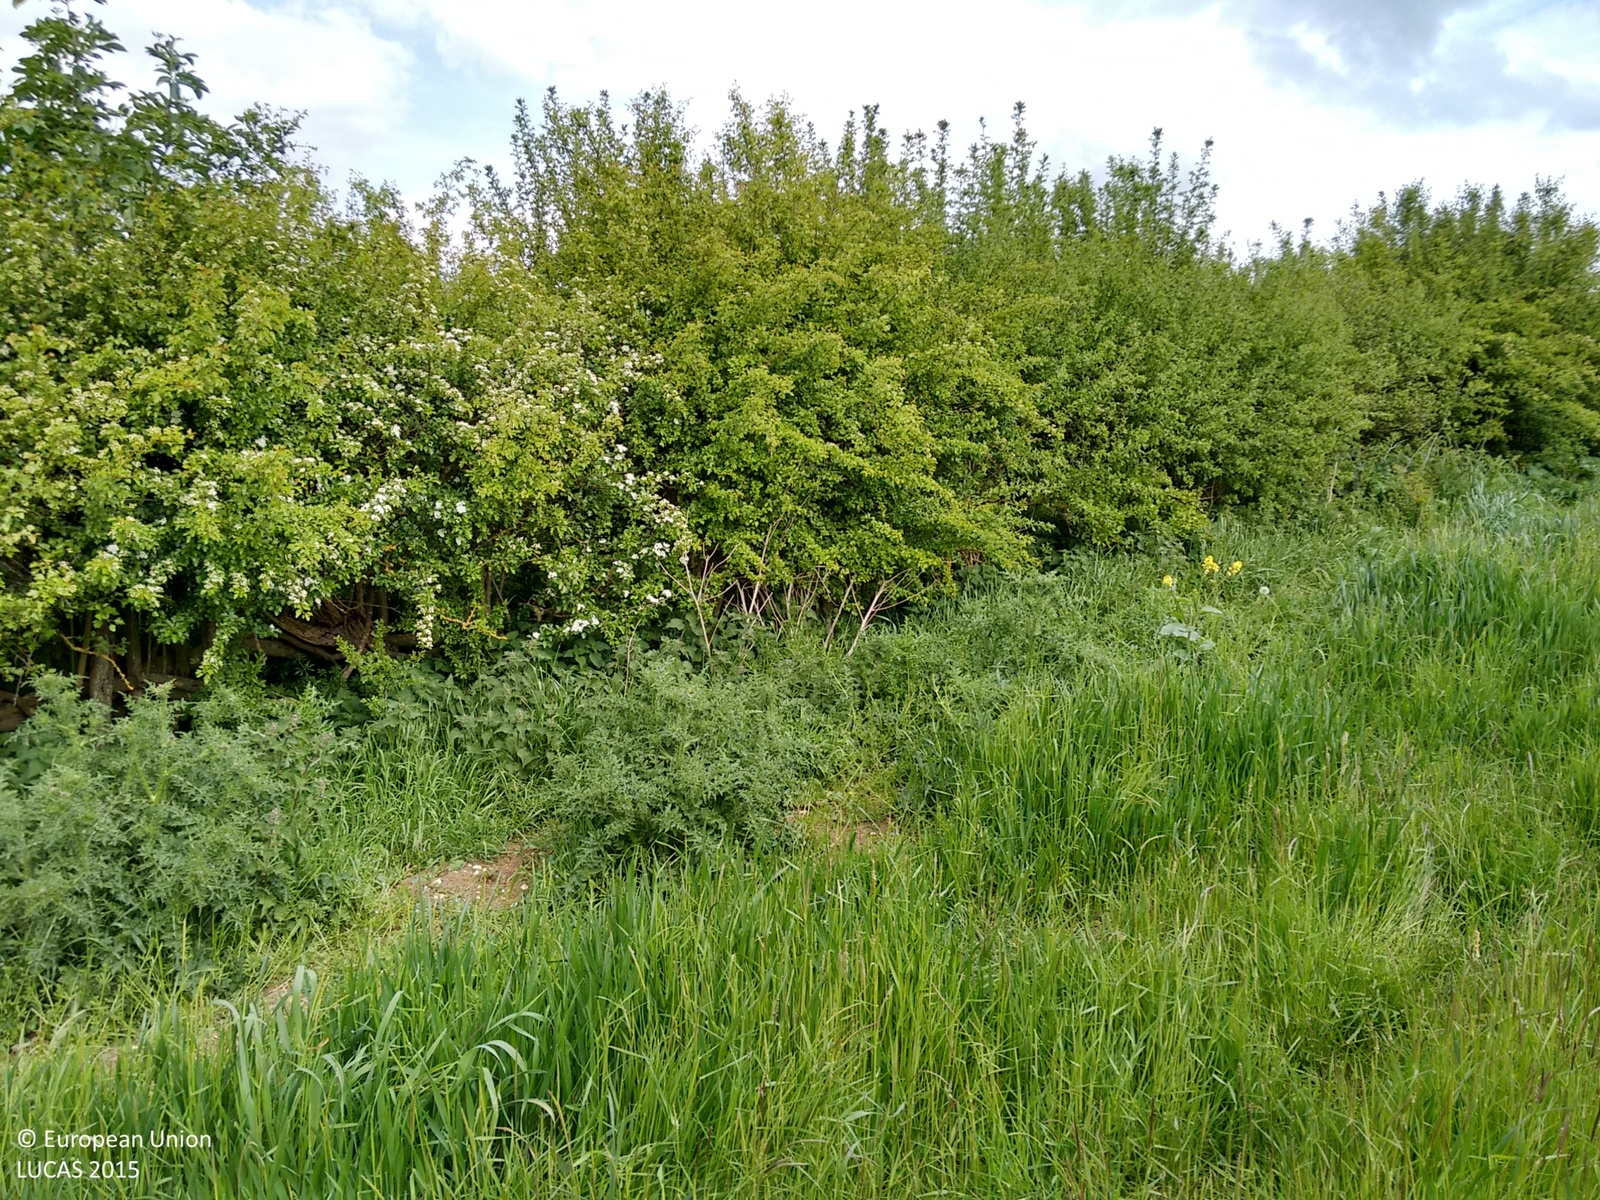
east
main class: Grassland
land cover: Grassland without tree/shrub cover
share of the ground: > 75 %
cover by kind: herbaceous plants 100 %
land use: Agriculture (excluding fallow land and kitchen gardens)
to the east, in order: Grassland without tree/shrub cover; Managed hedges; Grassland without tree/shrub cover; Rape and turnip rape
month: May
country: GB
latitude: 52.2007
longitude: -0.4997
